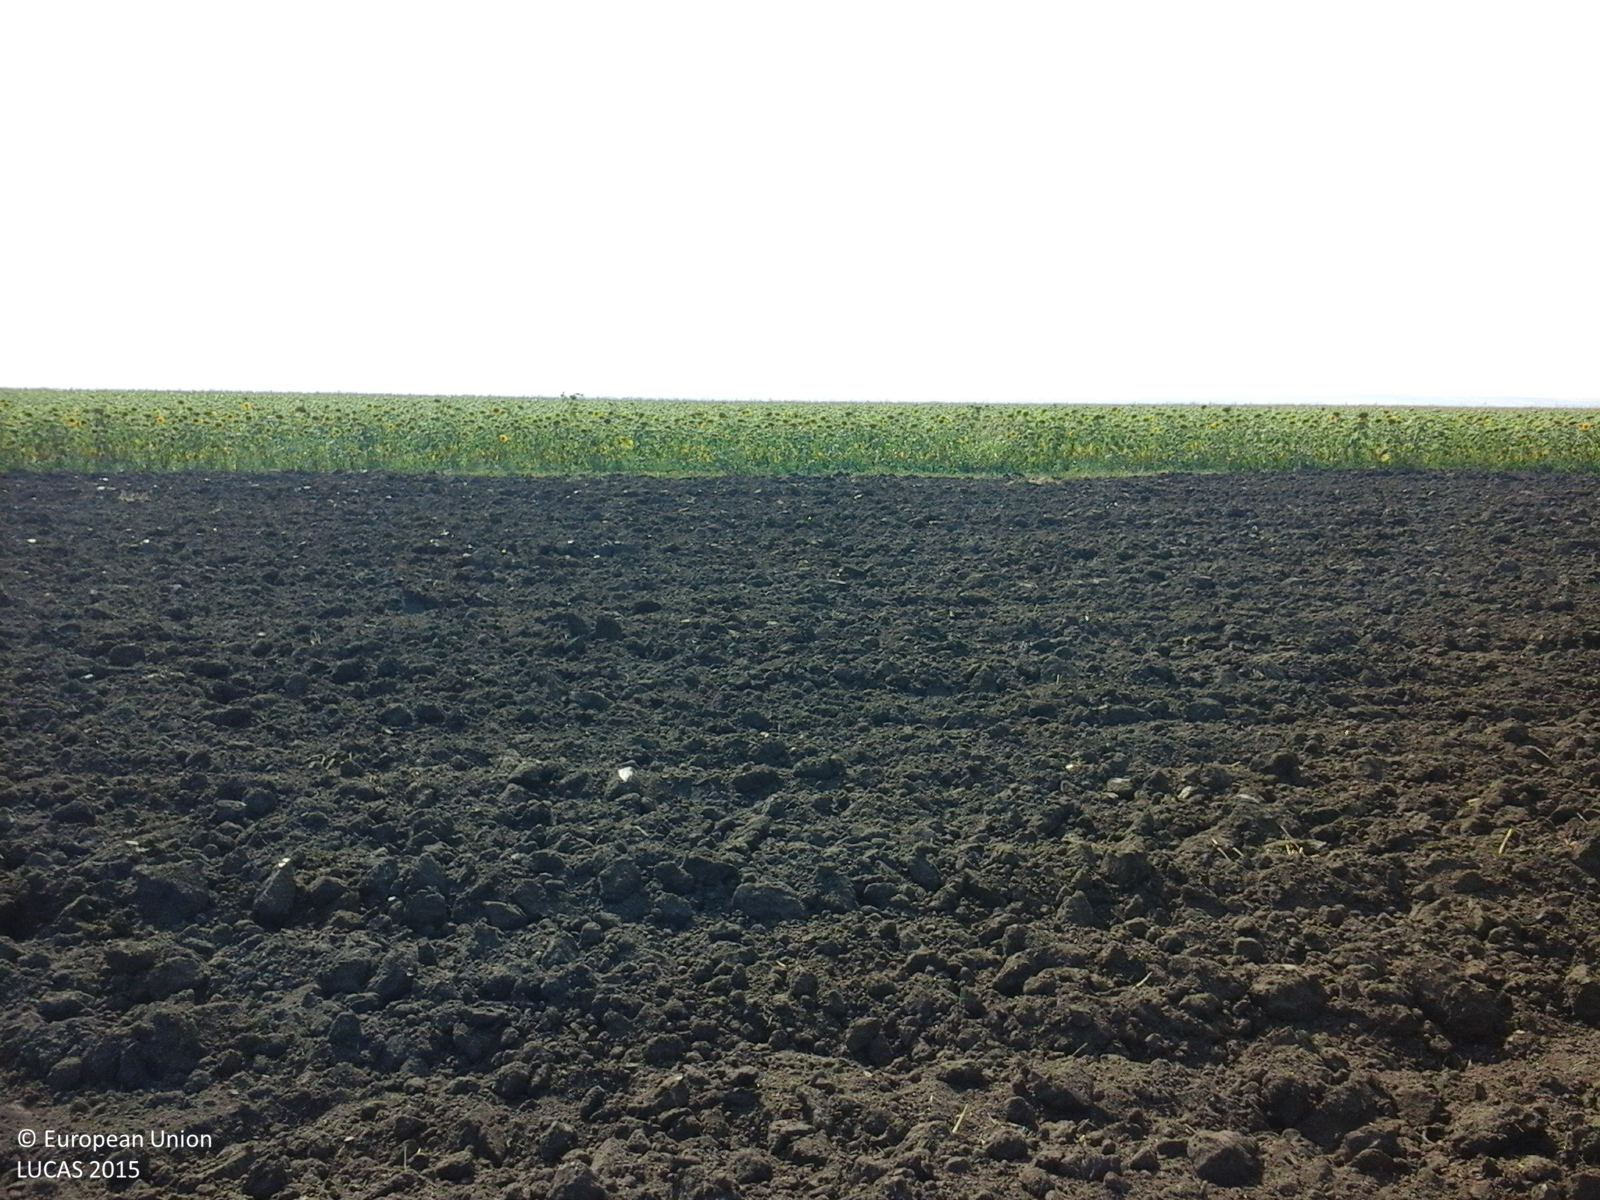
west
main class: Cropland
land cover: Common wheat
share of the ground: < 10 %
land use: Agriculture (excluding fallow land and kitchen gardens)
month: July
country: RO
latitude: 45.9947
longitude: 27.5246
